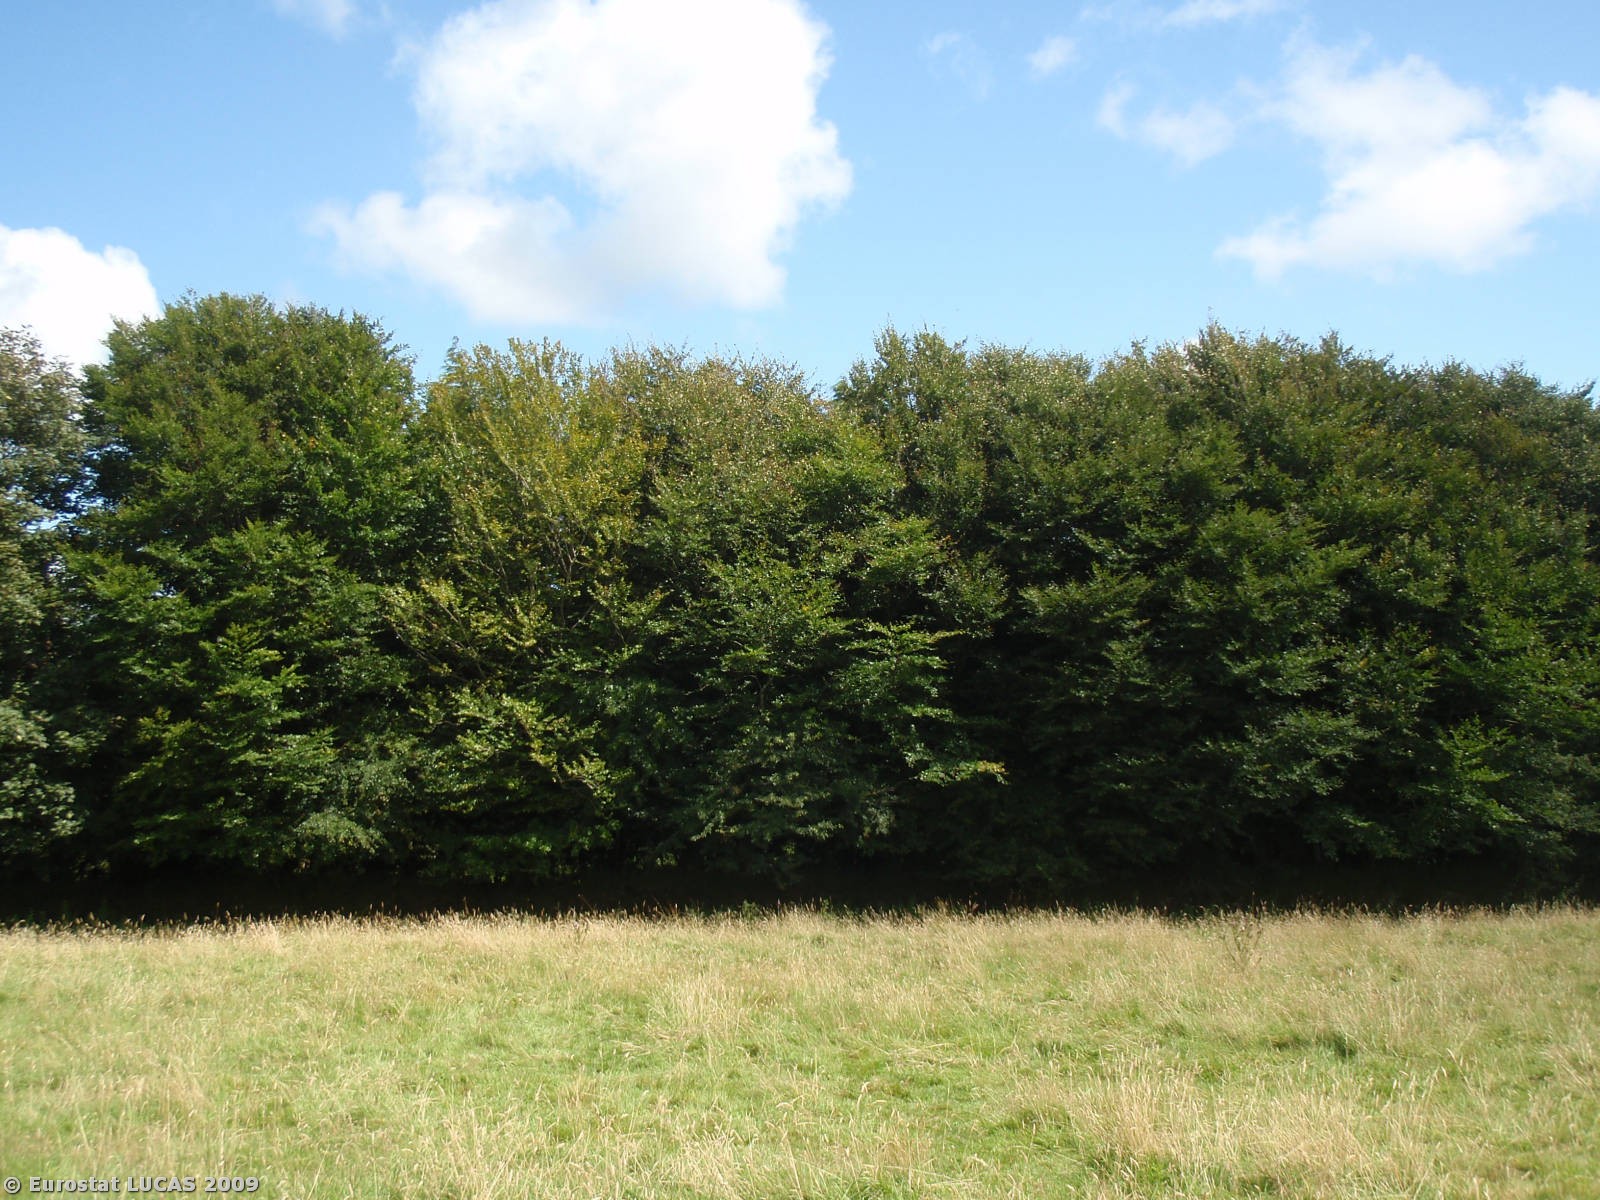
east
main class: Grassland
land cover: Grassland without tree/shrub cover
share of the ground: > 75 %
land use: Agriculture (excluding fallow land and kitchen gardens)
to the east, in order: Grassland without tree/shrub cover; Dry stone walls; Fences; Broadleaved woodland; Dry stone walls; Fences; Paved roads, cycling and walking lanes; Dry stone walls; Fences; Broadleaved woodland; Grassland without tree/shrub cover; Coniferous woodland; Grassland without tree/shrub cover; Dry stone walls; Fences; Grassland without tree/shrub cover
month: August
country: GB
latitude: 50.5465
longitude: -4.6577
